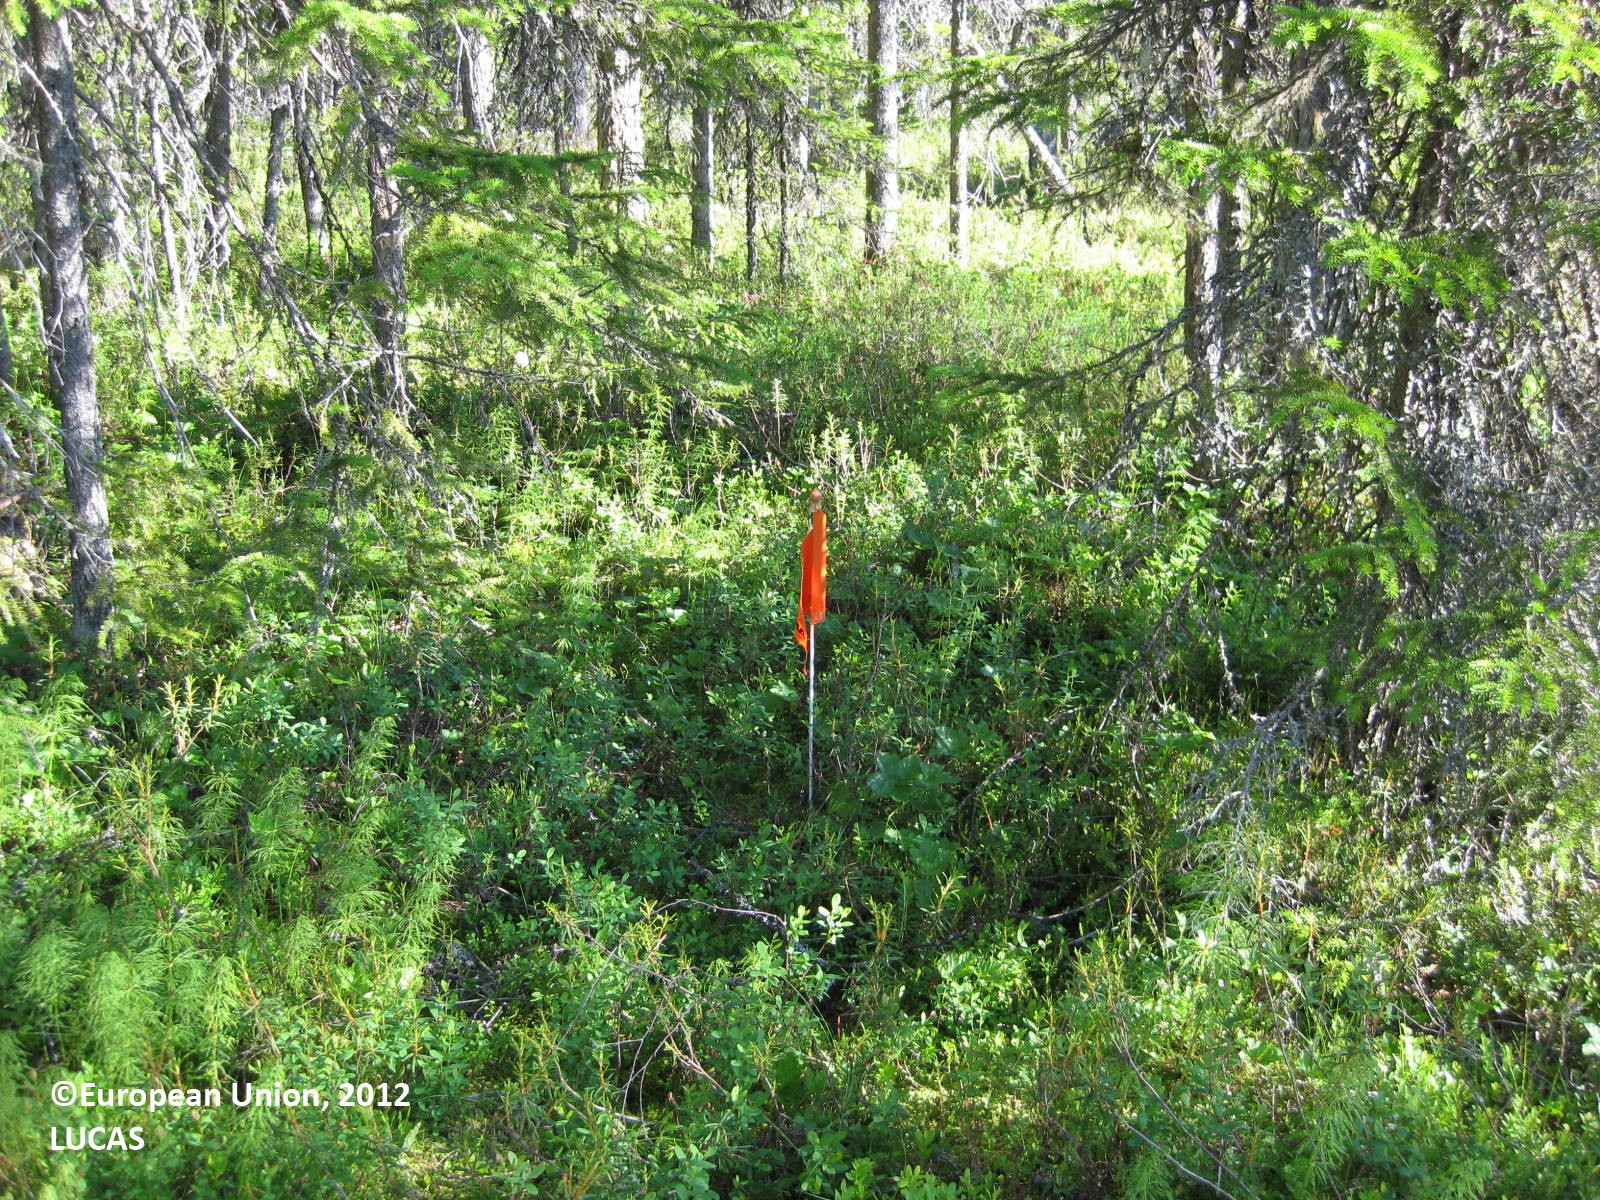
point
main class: Woodland
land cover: Spruce dominated coniferous woodland
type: mire and swamp forests
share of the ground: 50 - 75 %
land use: Forestry
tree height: > 5 m
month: July
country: FI
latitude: 65.5518
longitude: 29.4910
